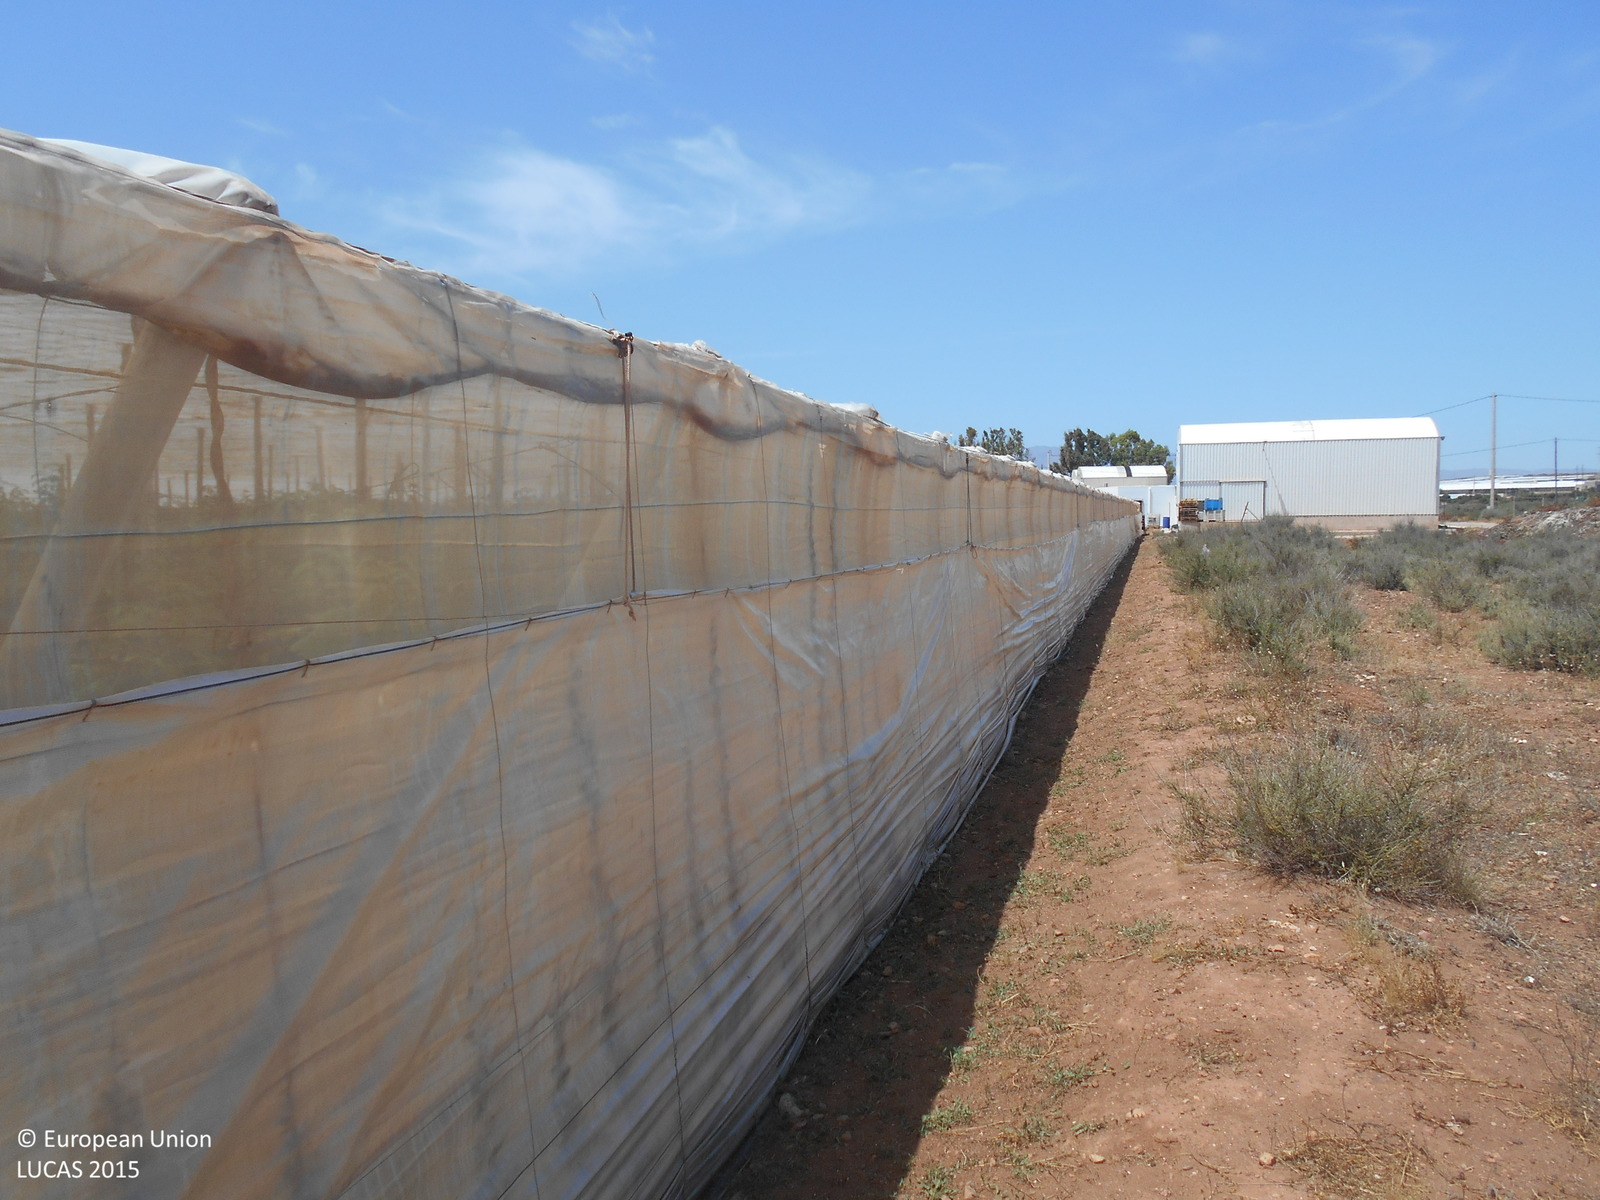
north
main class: Artificial land
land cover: Greenhouses
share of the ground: > 75 %
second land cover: Tomatoes
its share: 25 - 50 %
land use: Agriculture (excluding fallow land and kitchen gardens)
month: May
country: ES
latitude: 36.7911
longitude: -2.2216
